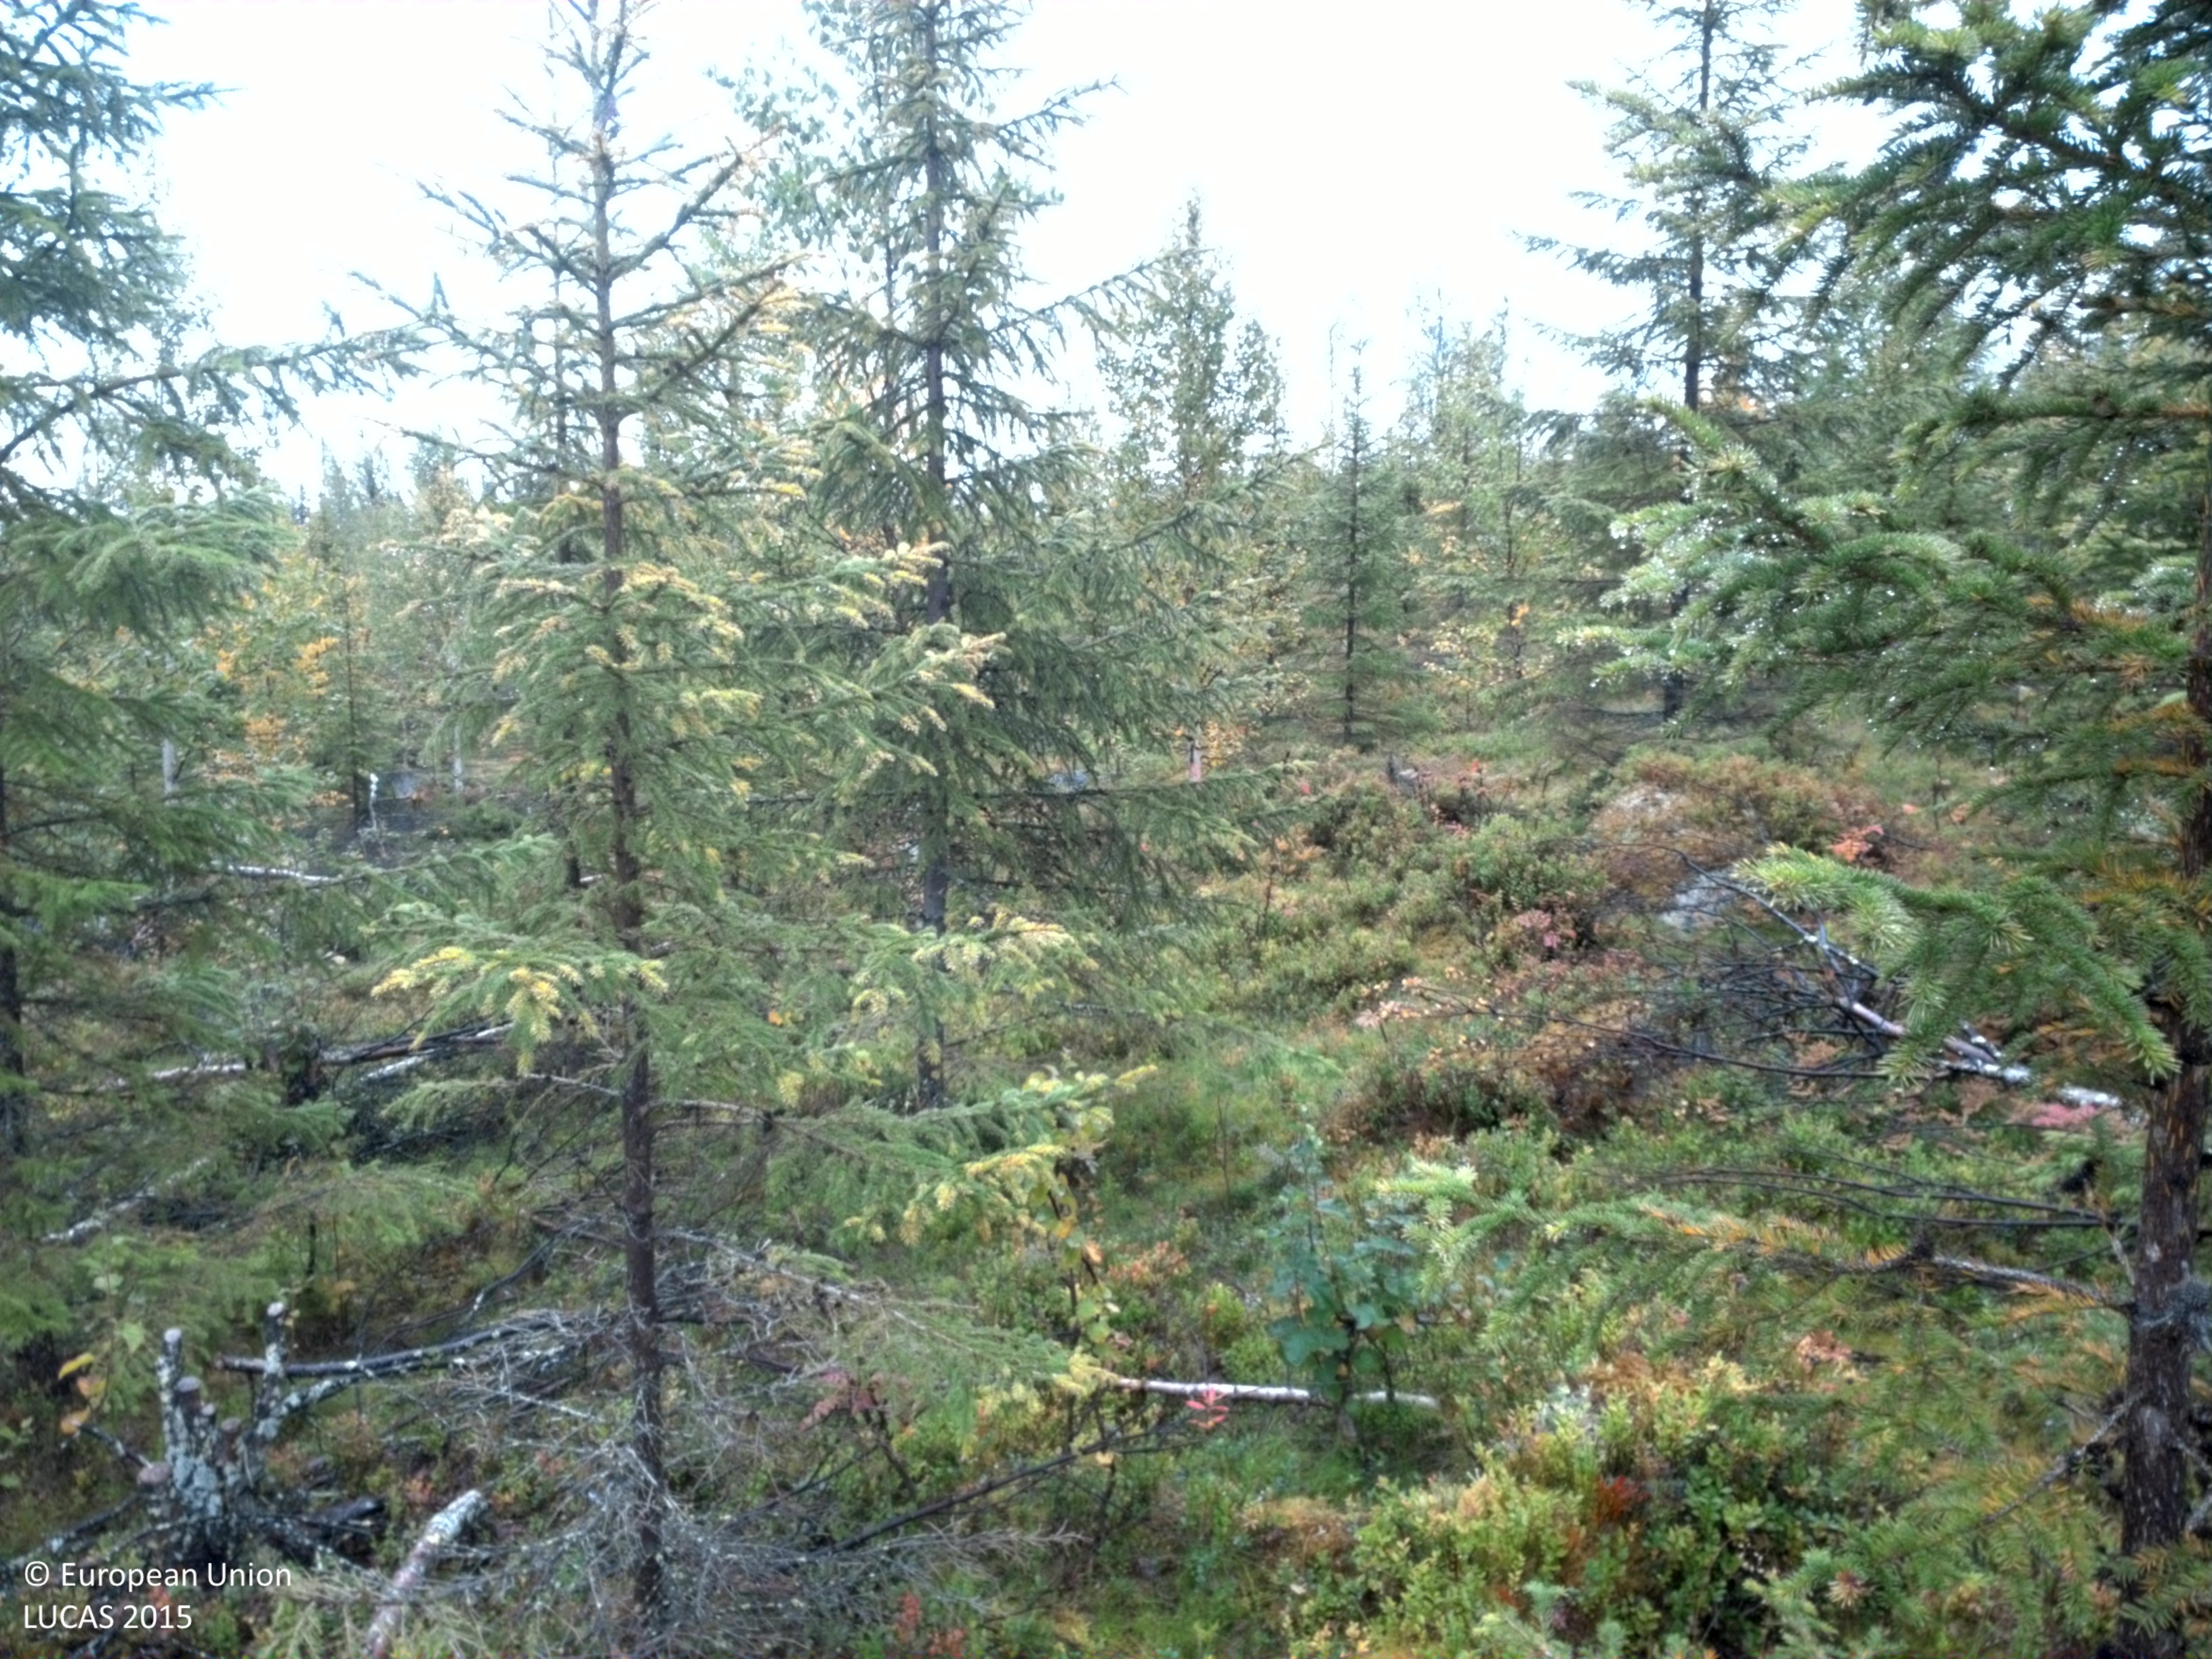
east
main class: Woodland
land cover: Spruce dominated mixed woodland
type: boreal forest
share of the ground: 10 - 25 %
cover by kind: shrubs 50 %, lichens and mosses 20 %, herbaceous plants 15 %, coniferous forest trees 10 %, broadleaved forest trees 5 %
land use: Forestry
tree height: > 5 m
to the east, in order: Spruce dominated mixed woodland; Spruce dominated coniferous woodland
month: September
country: SE
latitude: 65.1838
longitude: 16.6468
